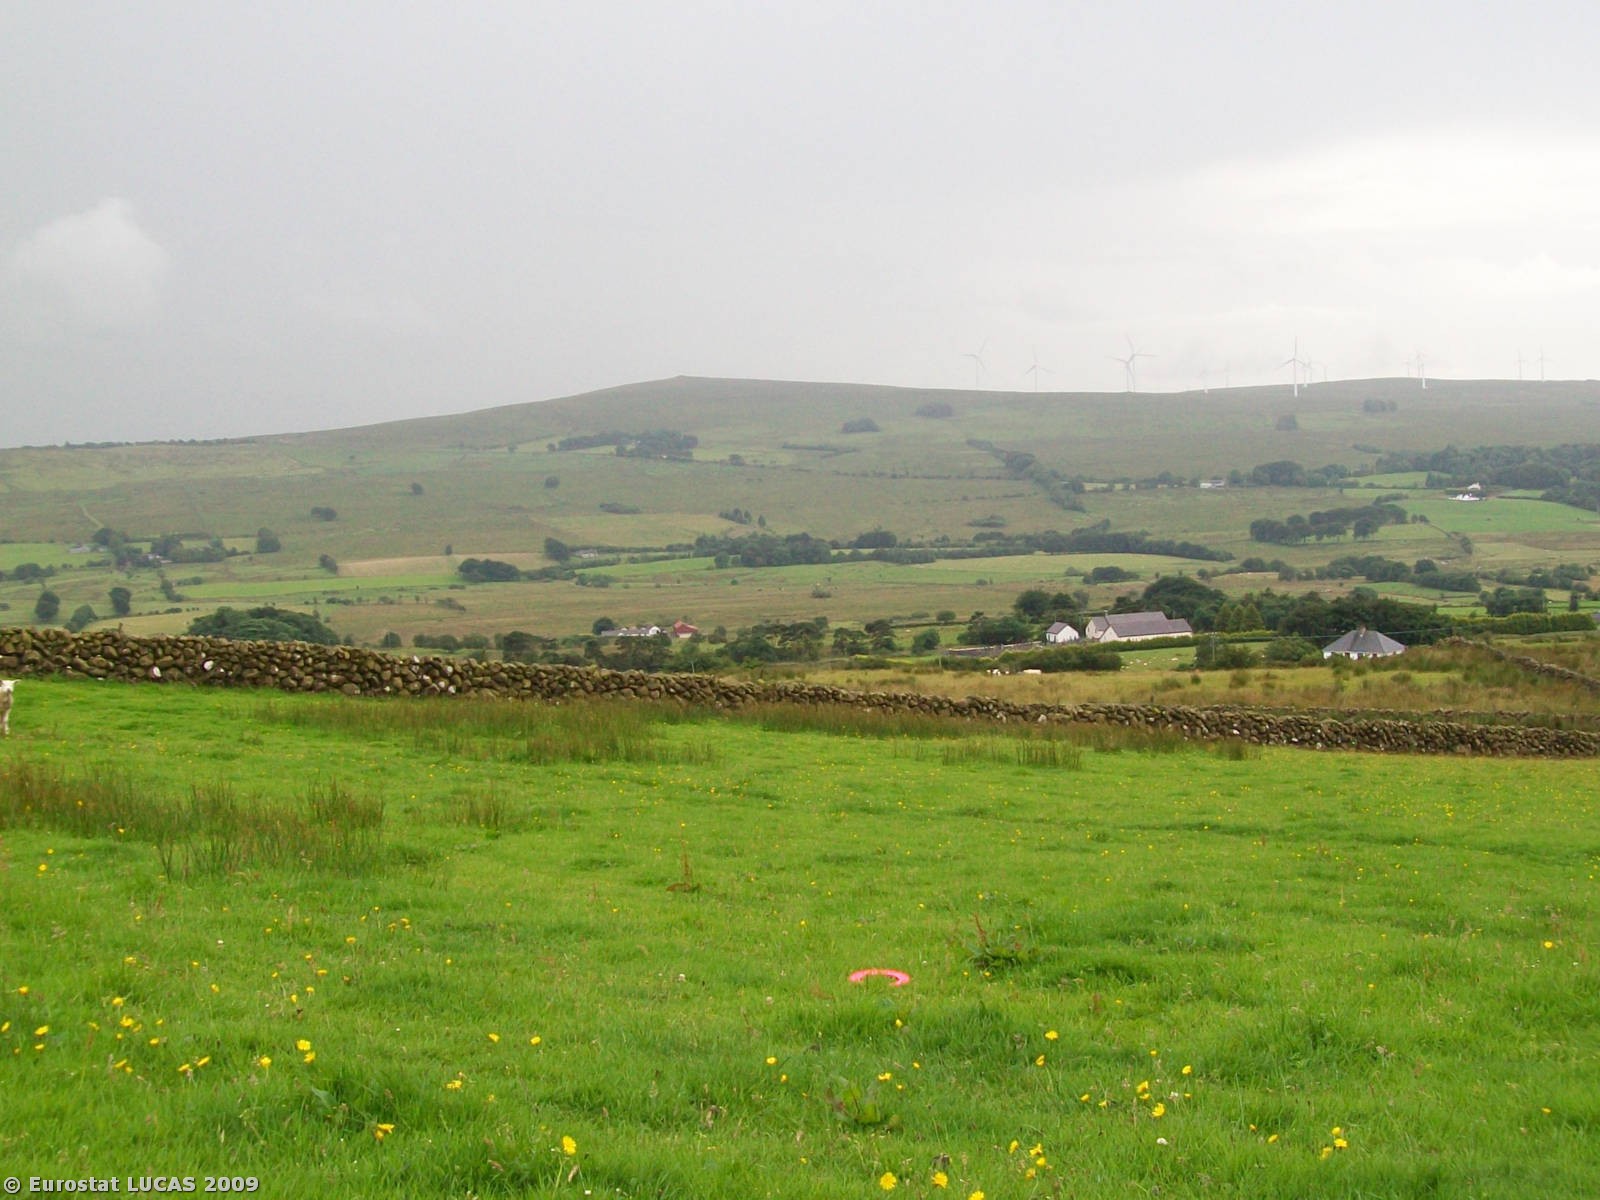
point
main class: Grassland
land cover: Grassland without tree/shrub cover
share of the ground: > 75 %
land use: Agriculture (excluding fallow land and kitchen gardens)
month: July
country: GB
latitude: 54.8343
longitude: -6.0688
